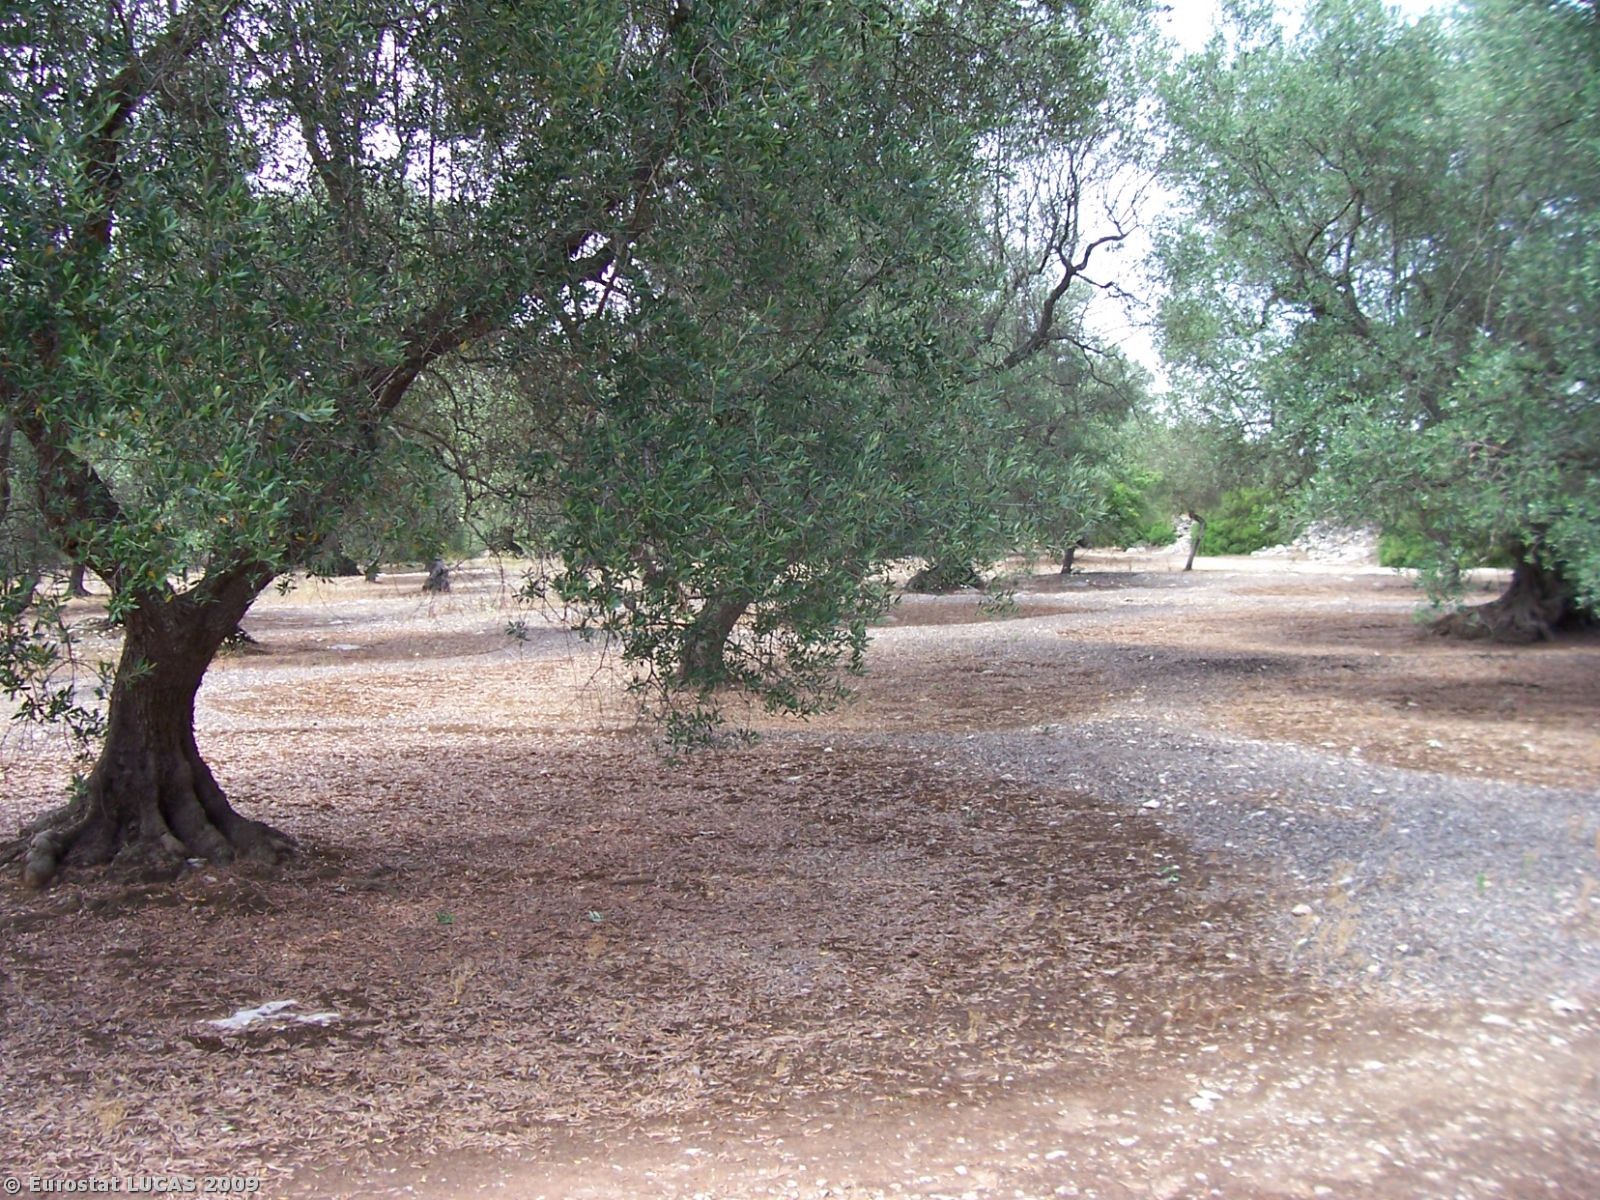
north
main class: Cropland
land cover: Olive groves
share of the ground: 25 - 50 %
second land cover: Bare land
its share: 50 - 75 %
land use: Agriculture (excluding fallow land and kitchen gardens)
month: June
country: IT
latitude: 40.3255
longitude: 17.4952
